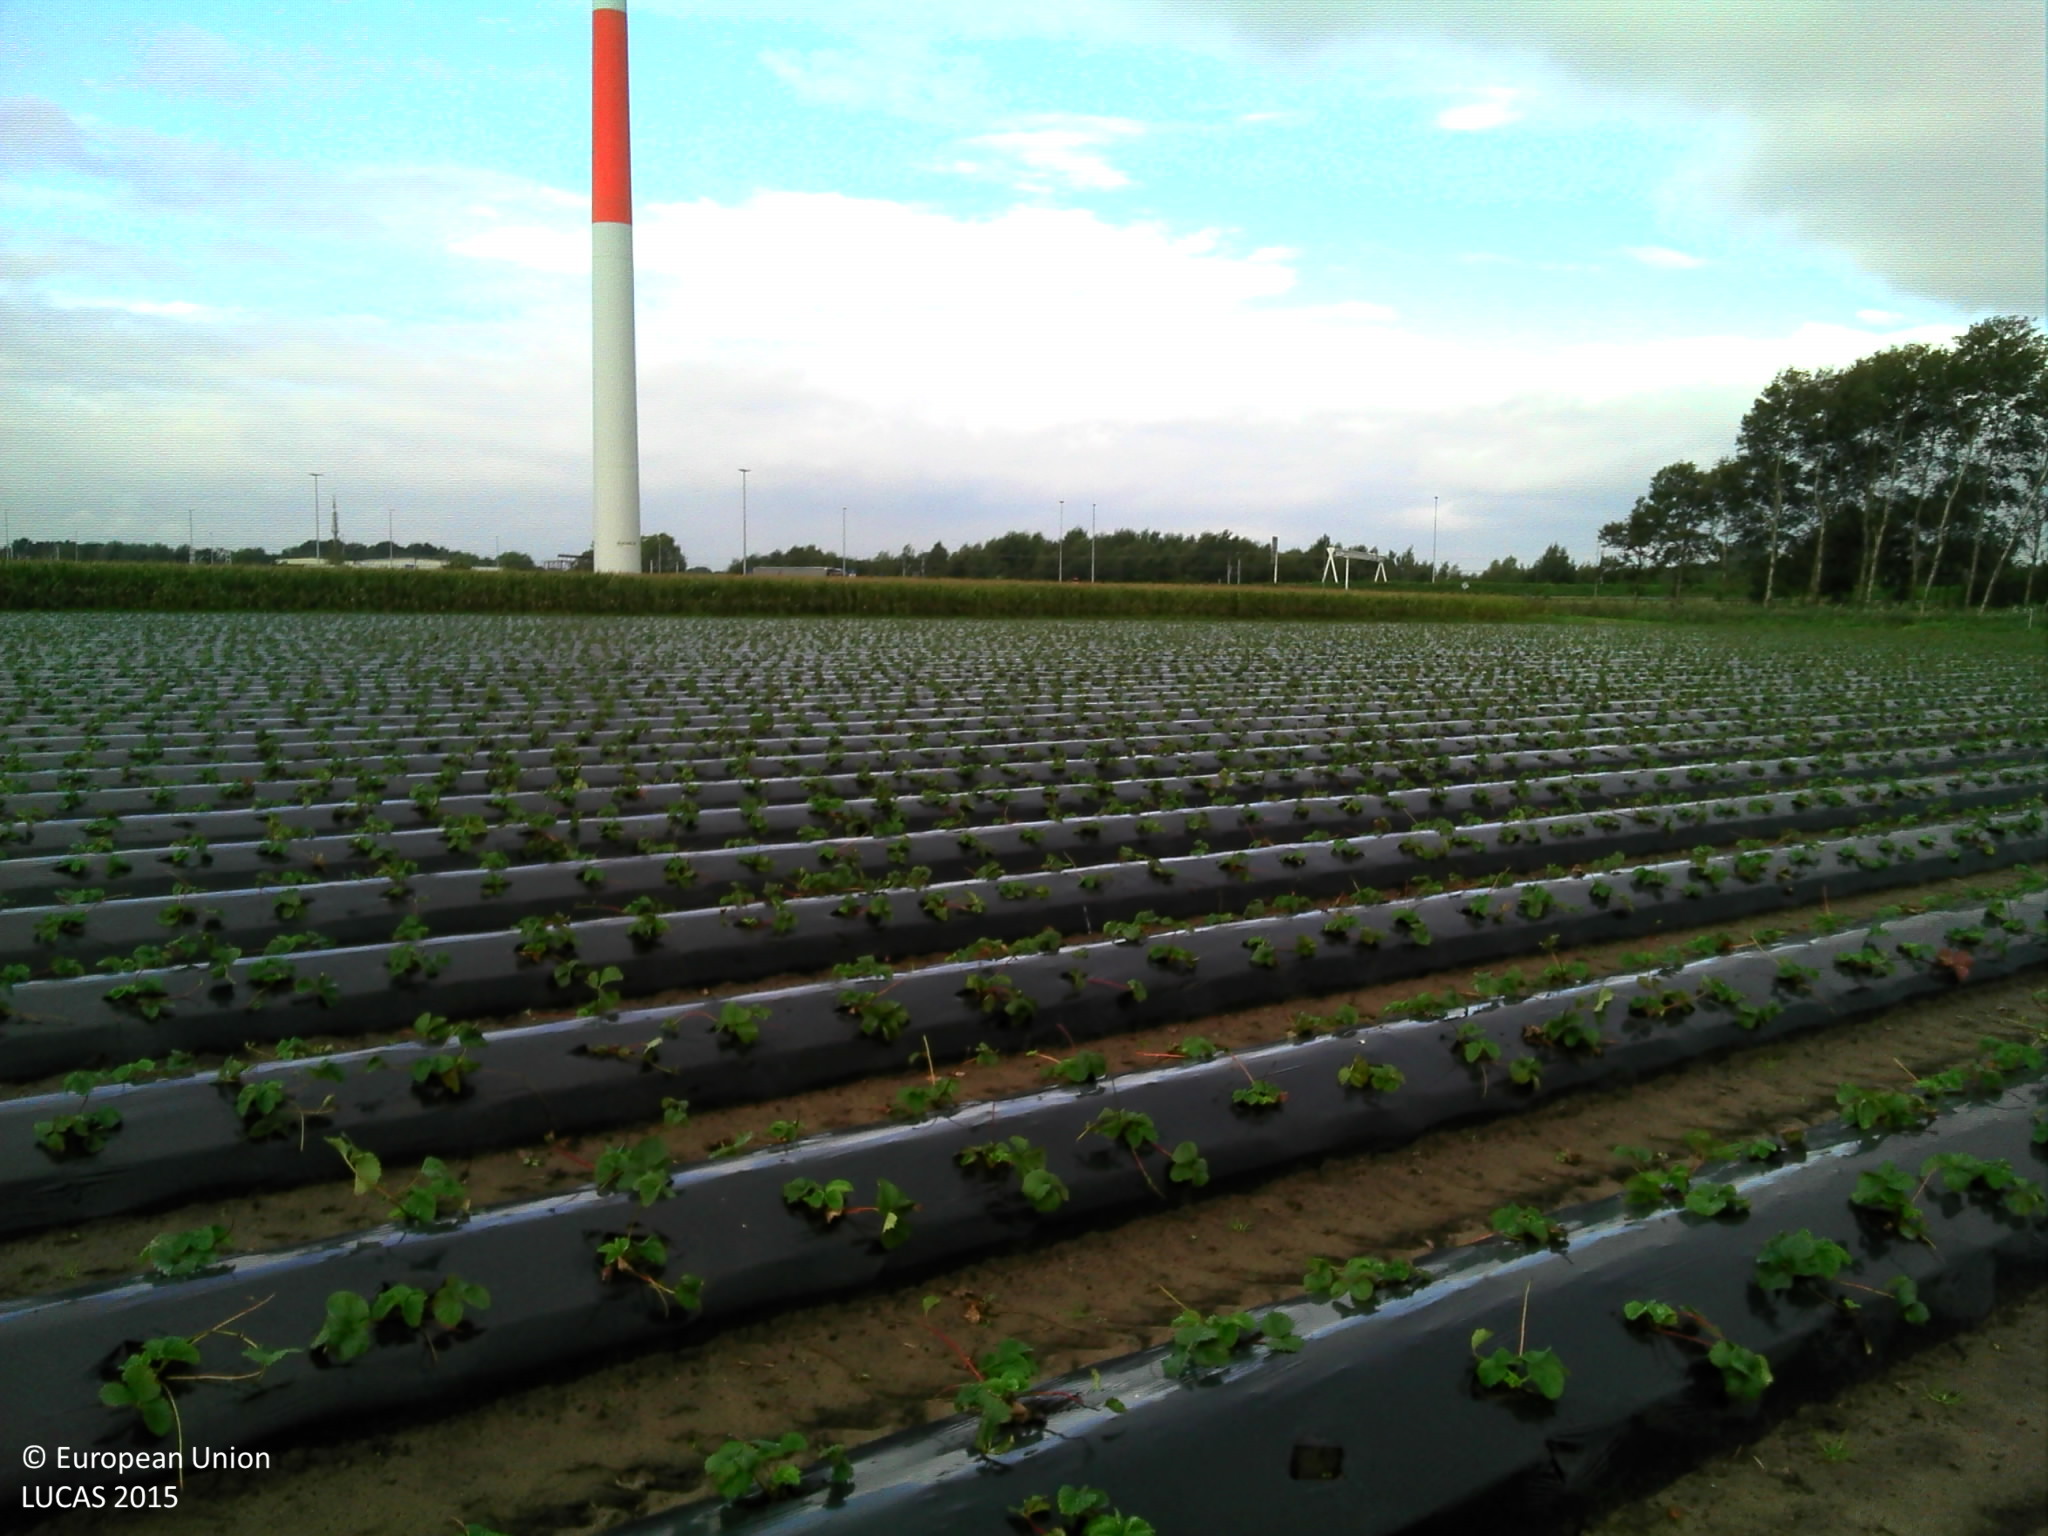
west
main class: Cropland
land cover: Strawberries
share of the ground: < 10 %
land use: Agriculture (excluding fallow land and kitchen gardens)
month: September
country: BE
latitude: 51.4863
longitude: 4.7400
